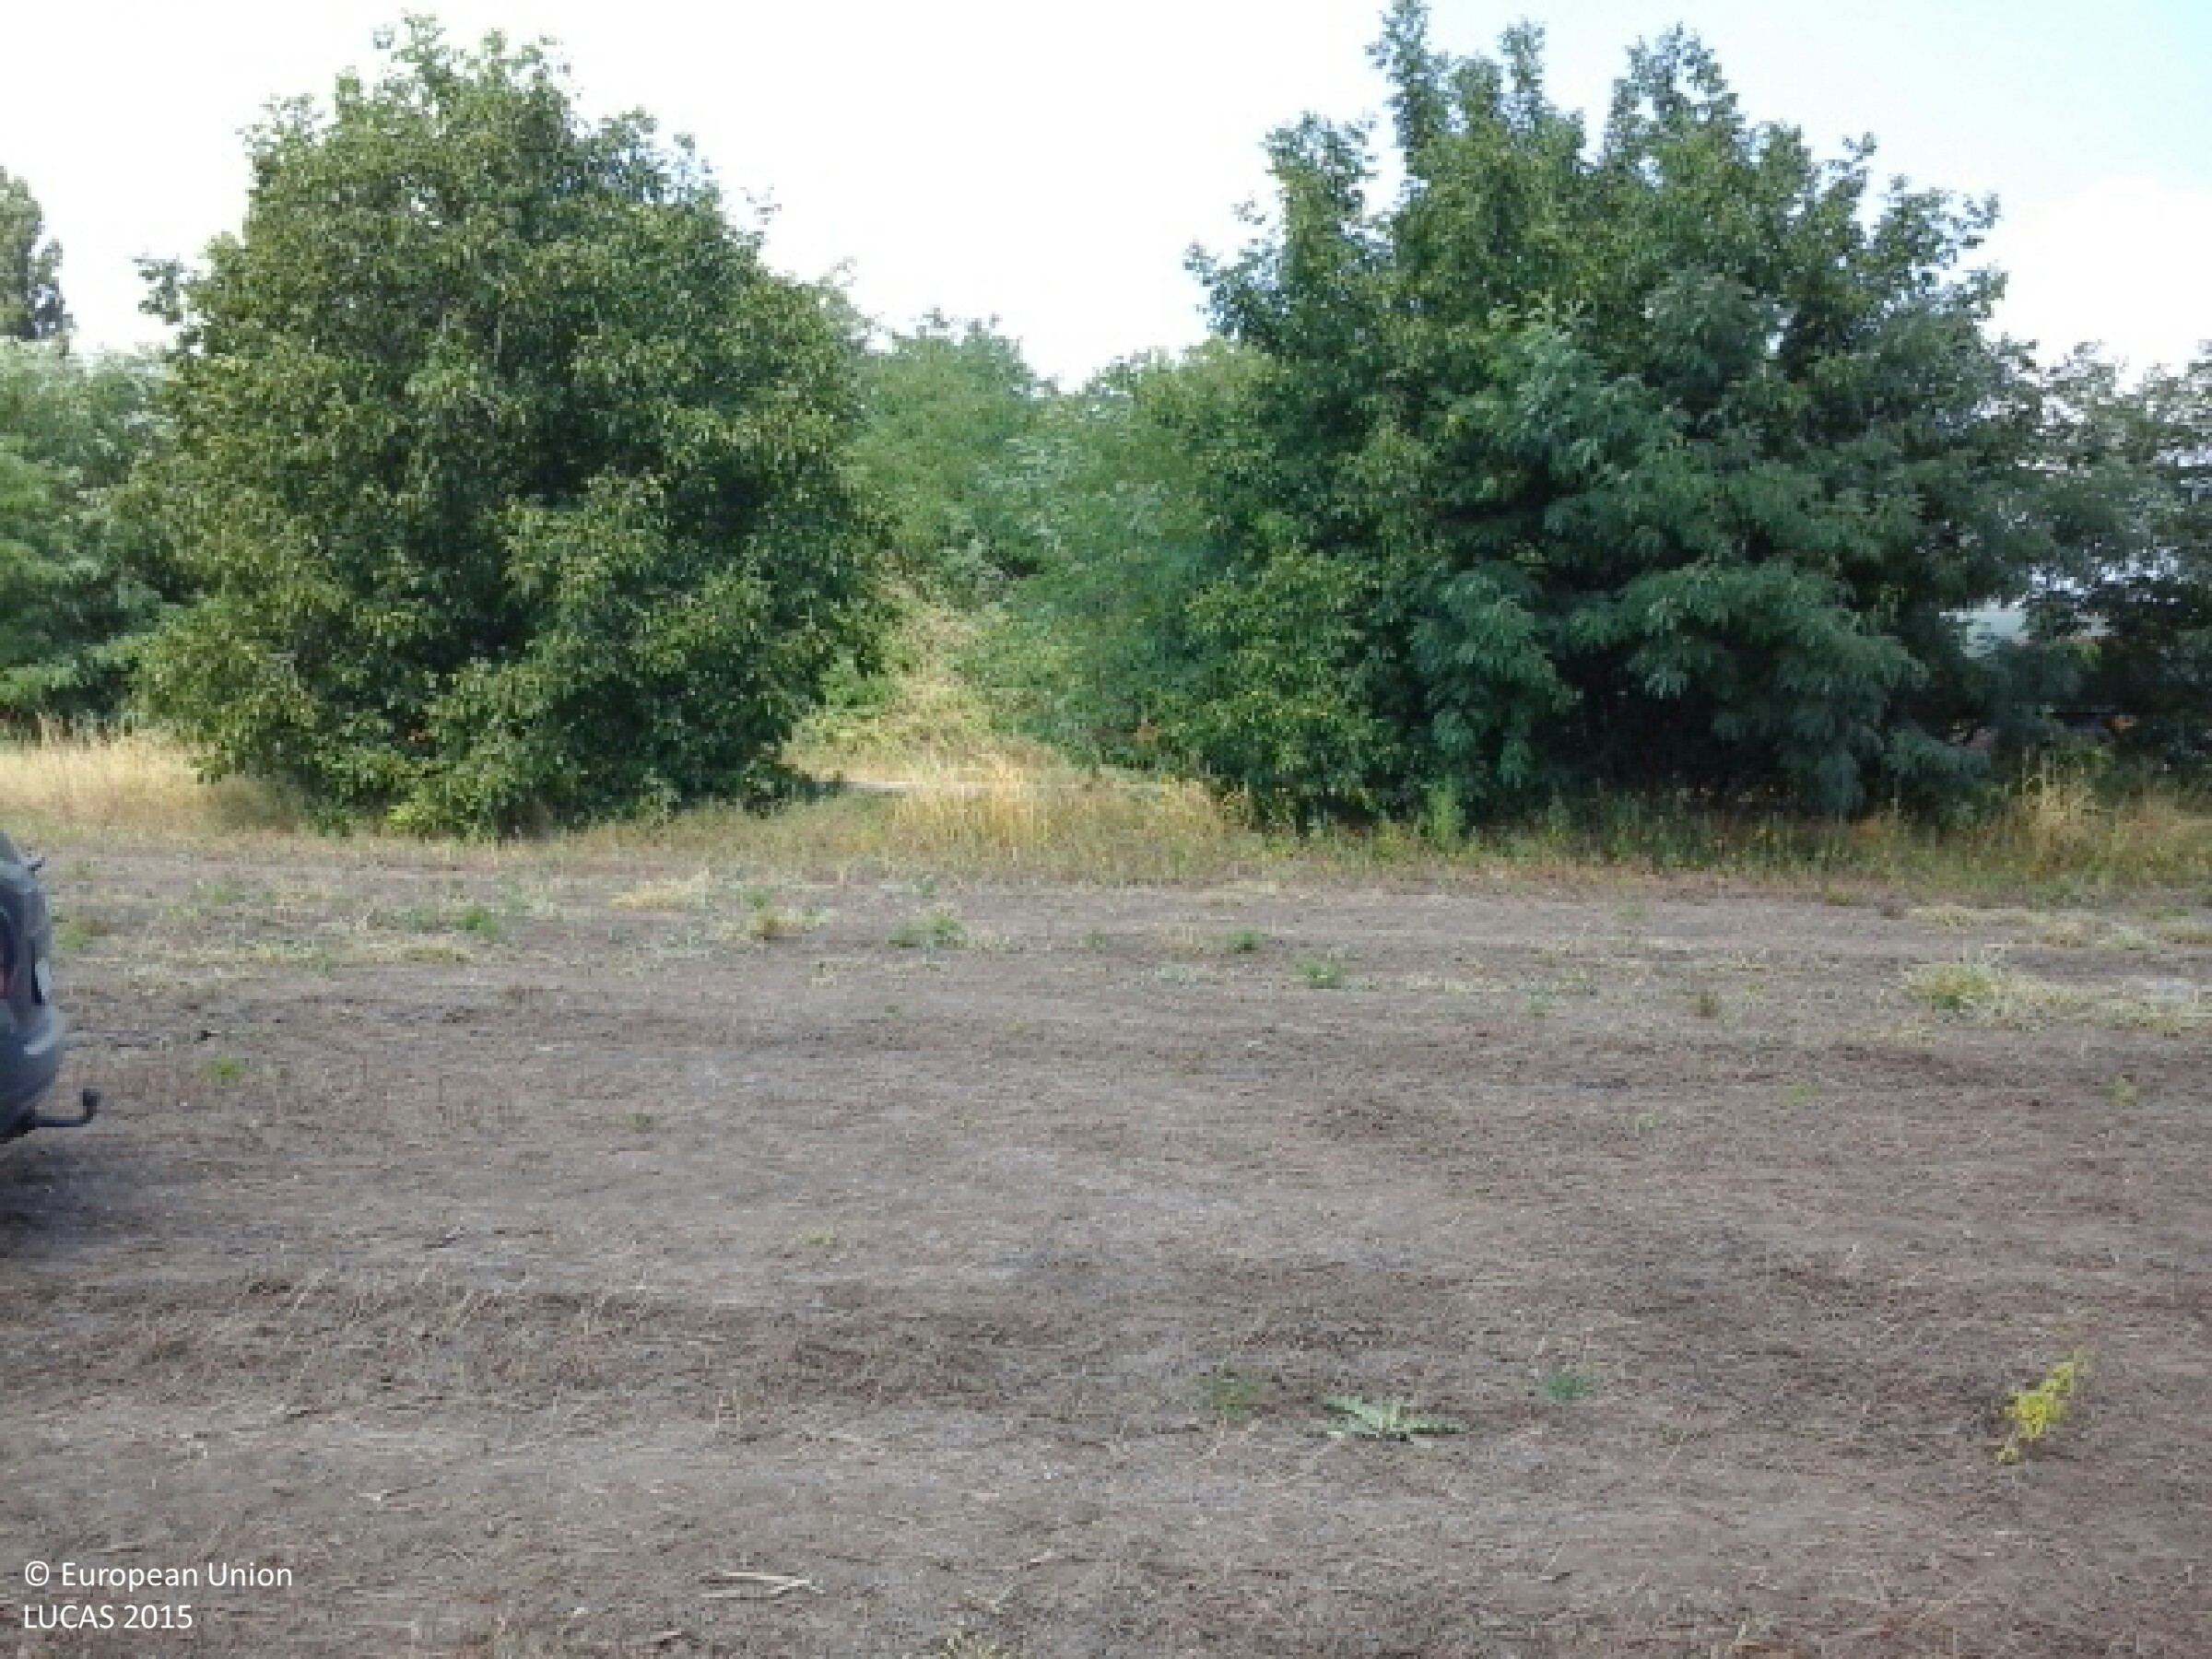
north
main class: Cropland
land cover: Common wheat
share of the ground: > 75 %
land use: Agriculture (excluding fallow land and kitchen gardens)
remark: Harvested field
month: August
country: HU
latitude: 47.7158
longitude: 17.9959
